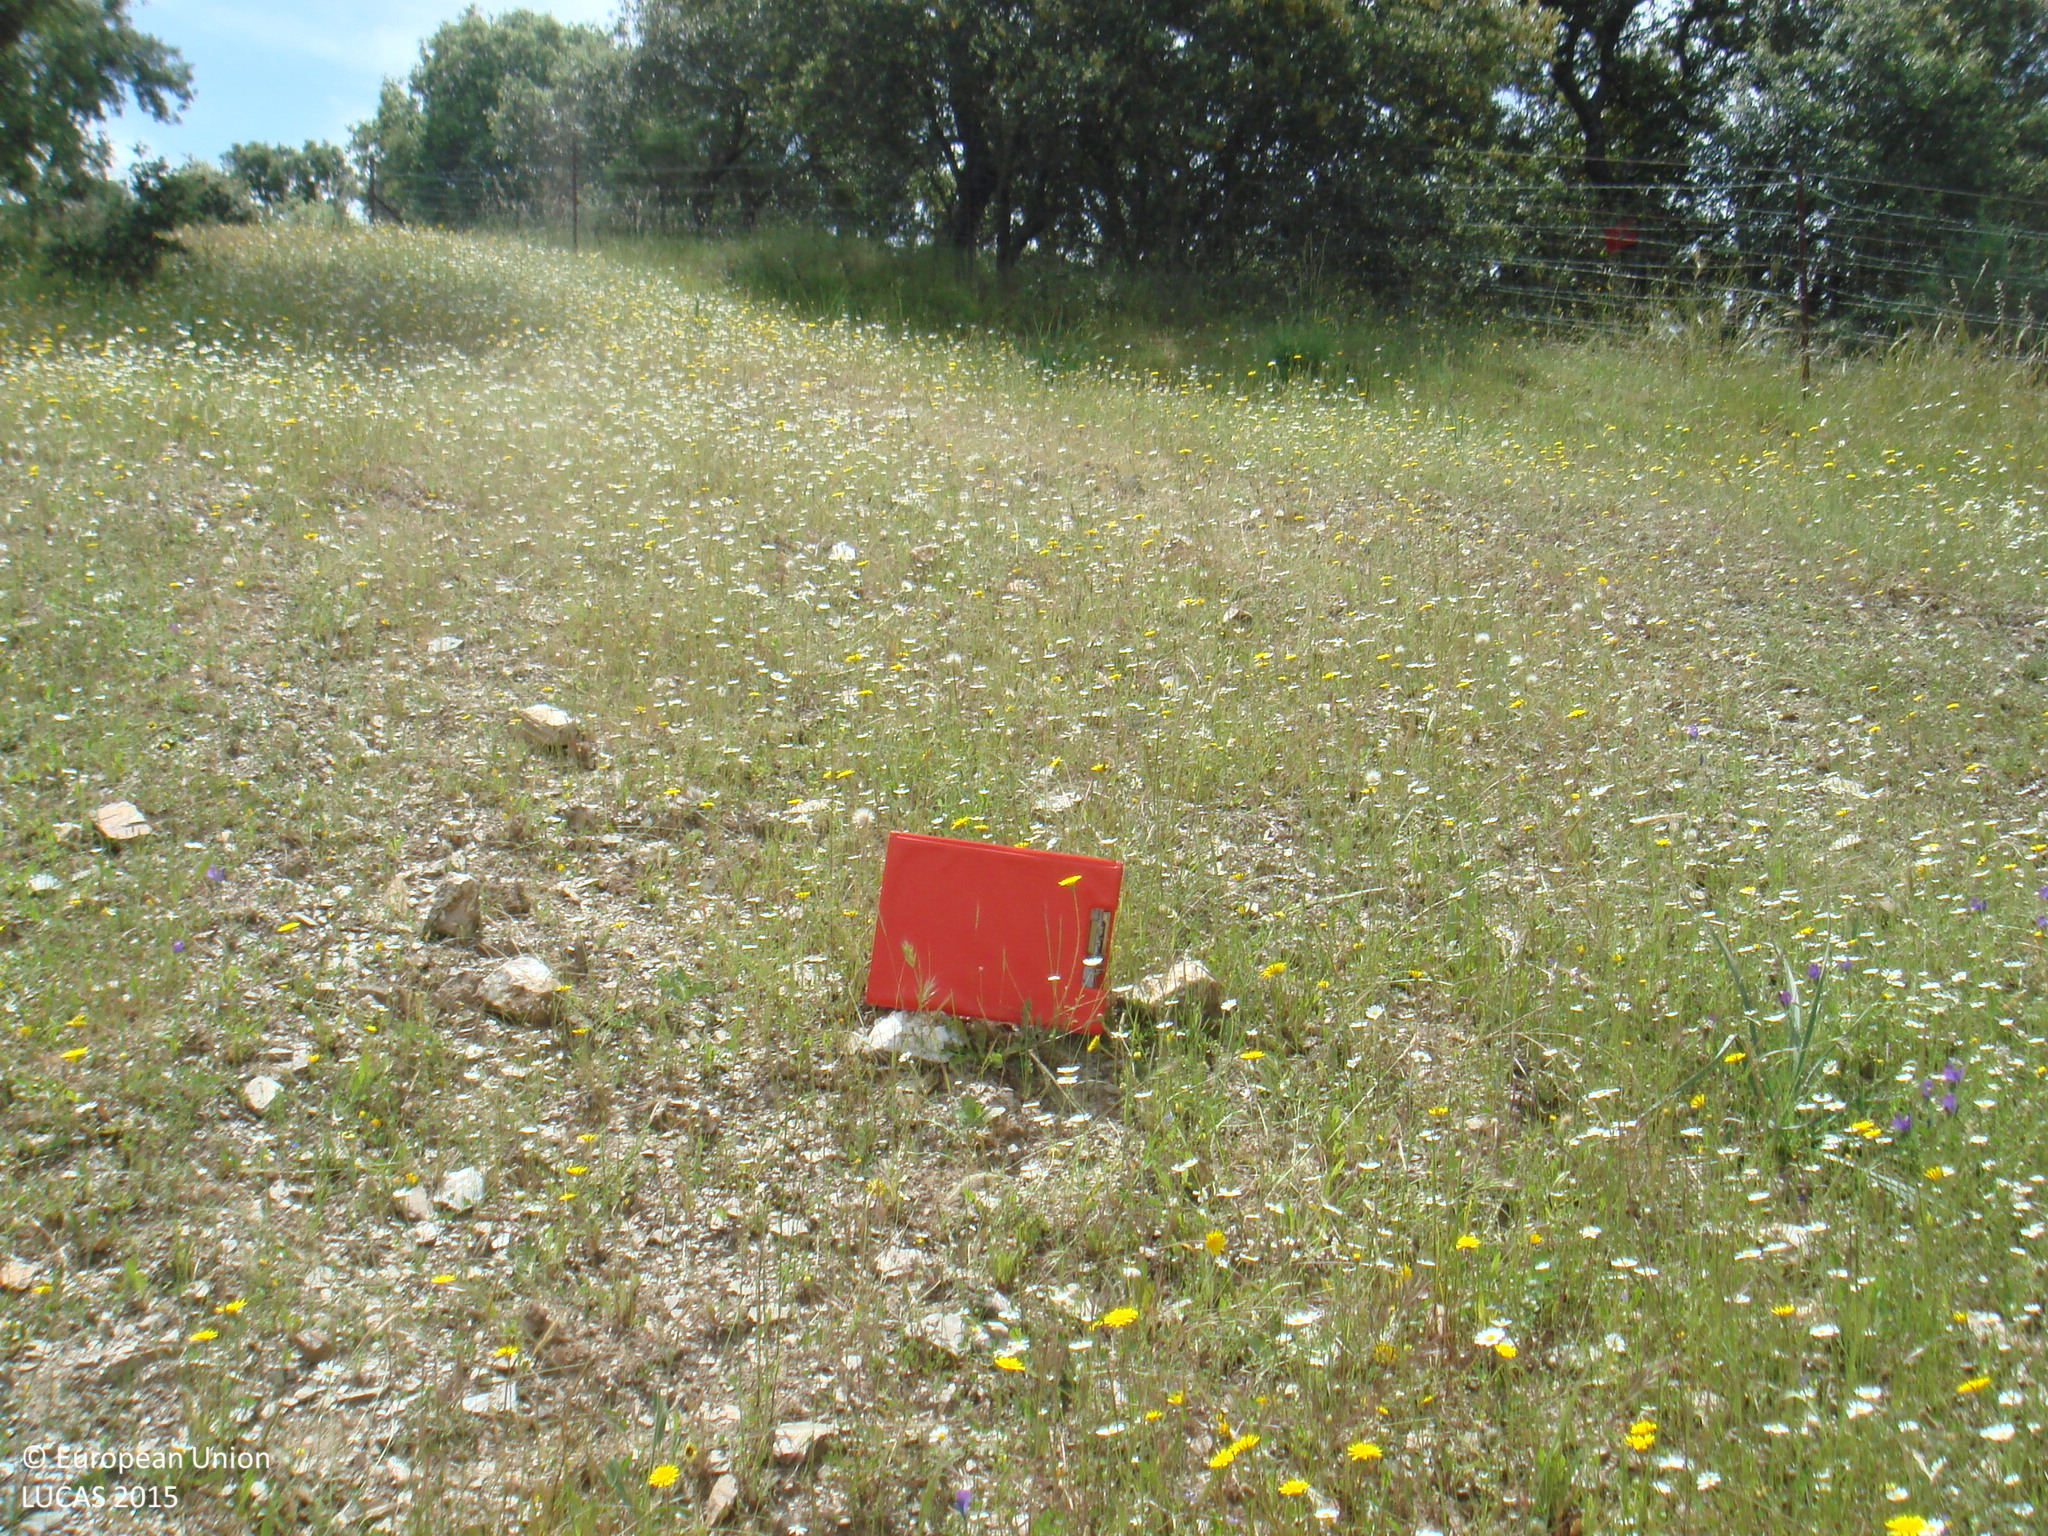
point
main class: Woodland
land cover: Broadleaved woodland
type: broadleaved evergreen forest
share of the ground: 25 - 50 %
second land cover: Spontaneously vegetated surfaces
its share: > 75 %
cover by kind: herbaceous plants 50 %, broadleaved forest trees 40 %, shrubs 10 %
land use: Forestry
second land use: Agriculture (excluding fallow land and kitchen gardens)
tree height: > 5 m
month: May
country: ES
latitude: 38.3988
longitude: -5.0612
